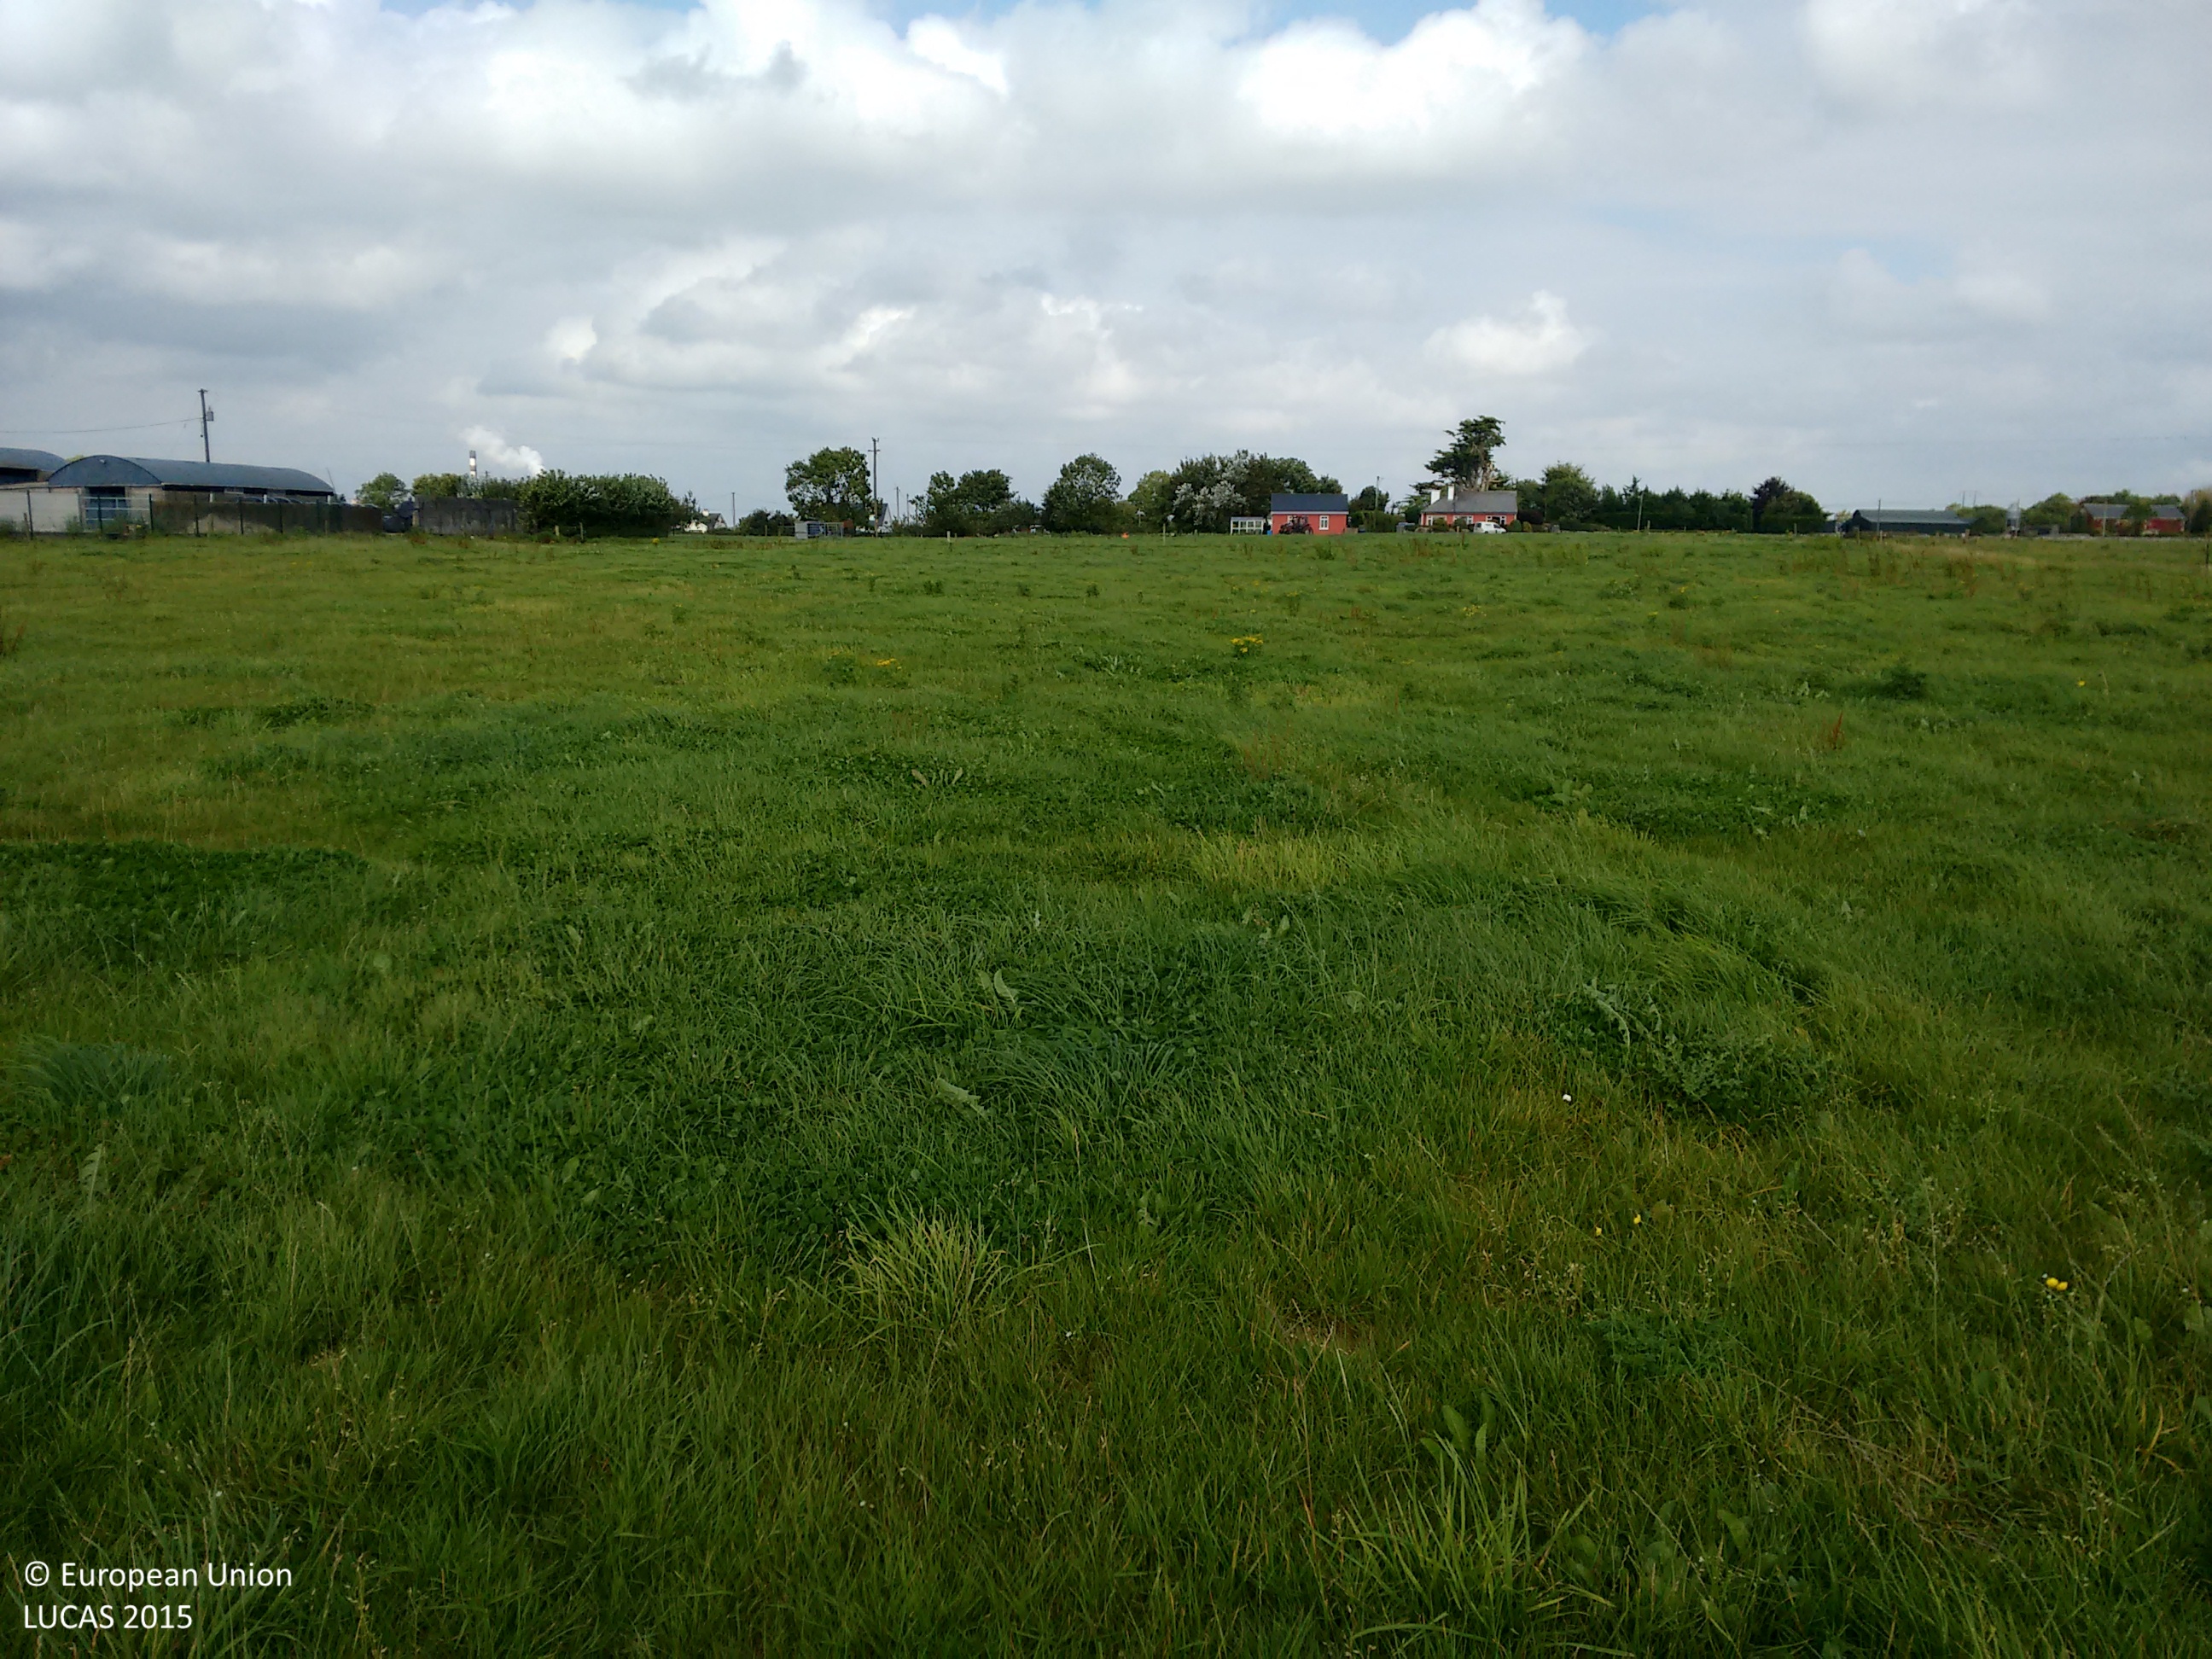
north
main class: Grassland
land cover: Grassland without tree/shrub cover
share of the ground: > 75 %
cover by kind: herbaceous plants 100 %
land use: Agriculture (excluding fallow land and kitchen gardens)
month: September
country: IE
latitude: 52.6095
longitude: -9.0433
